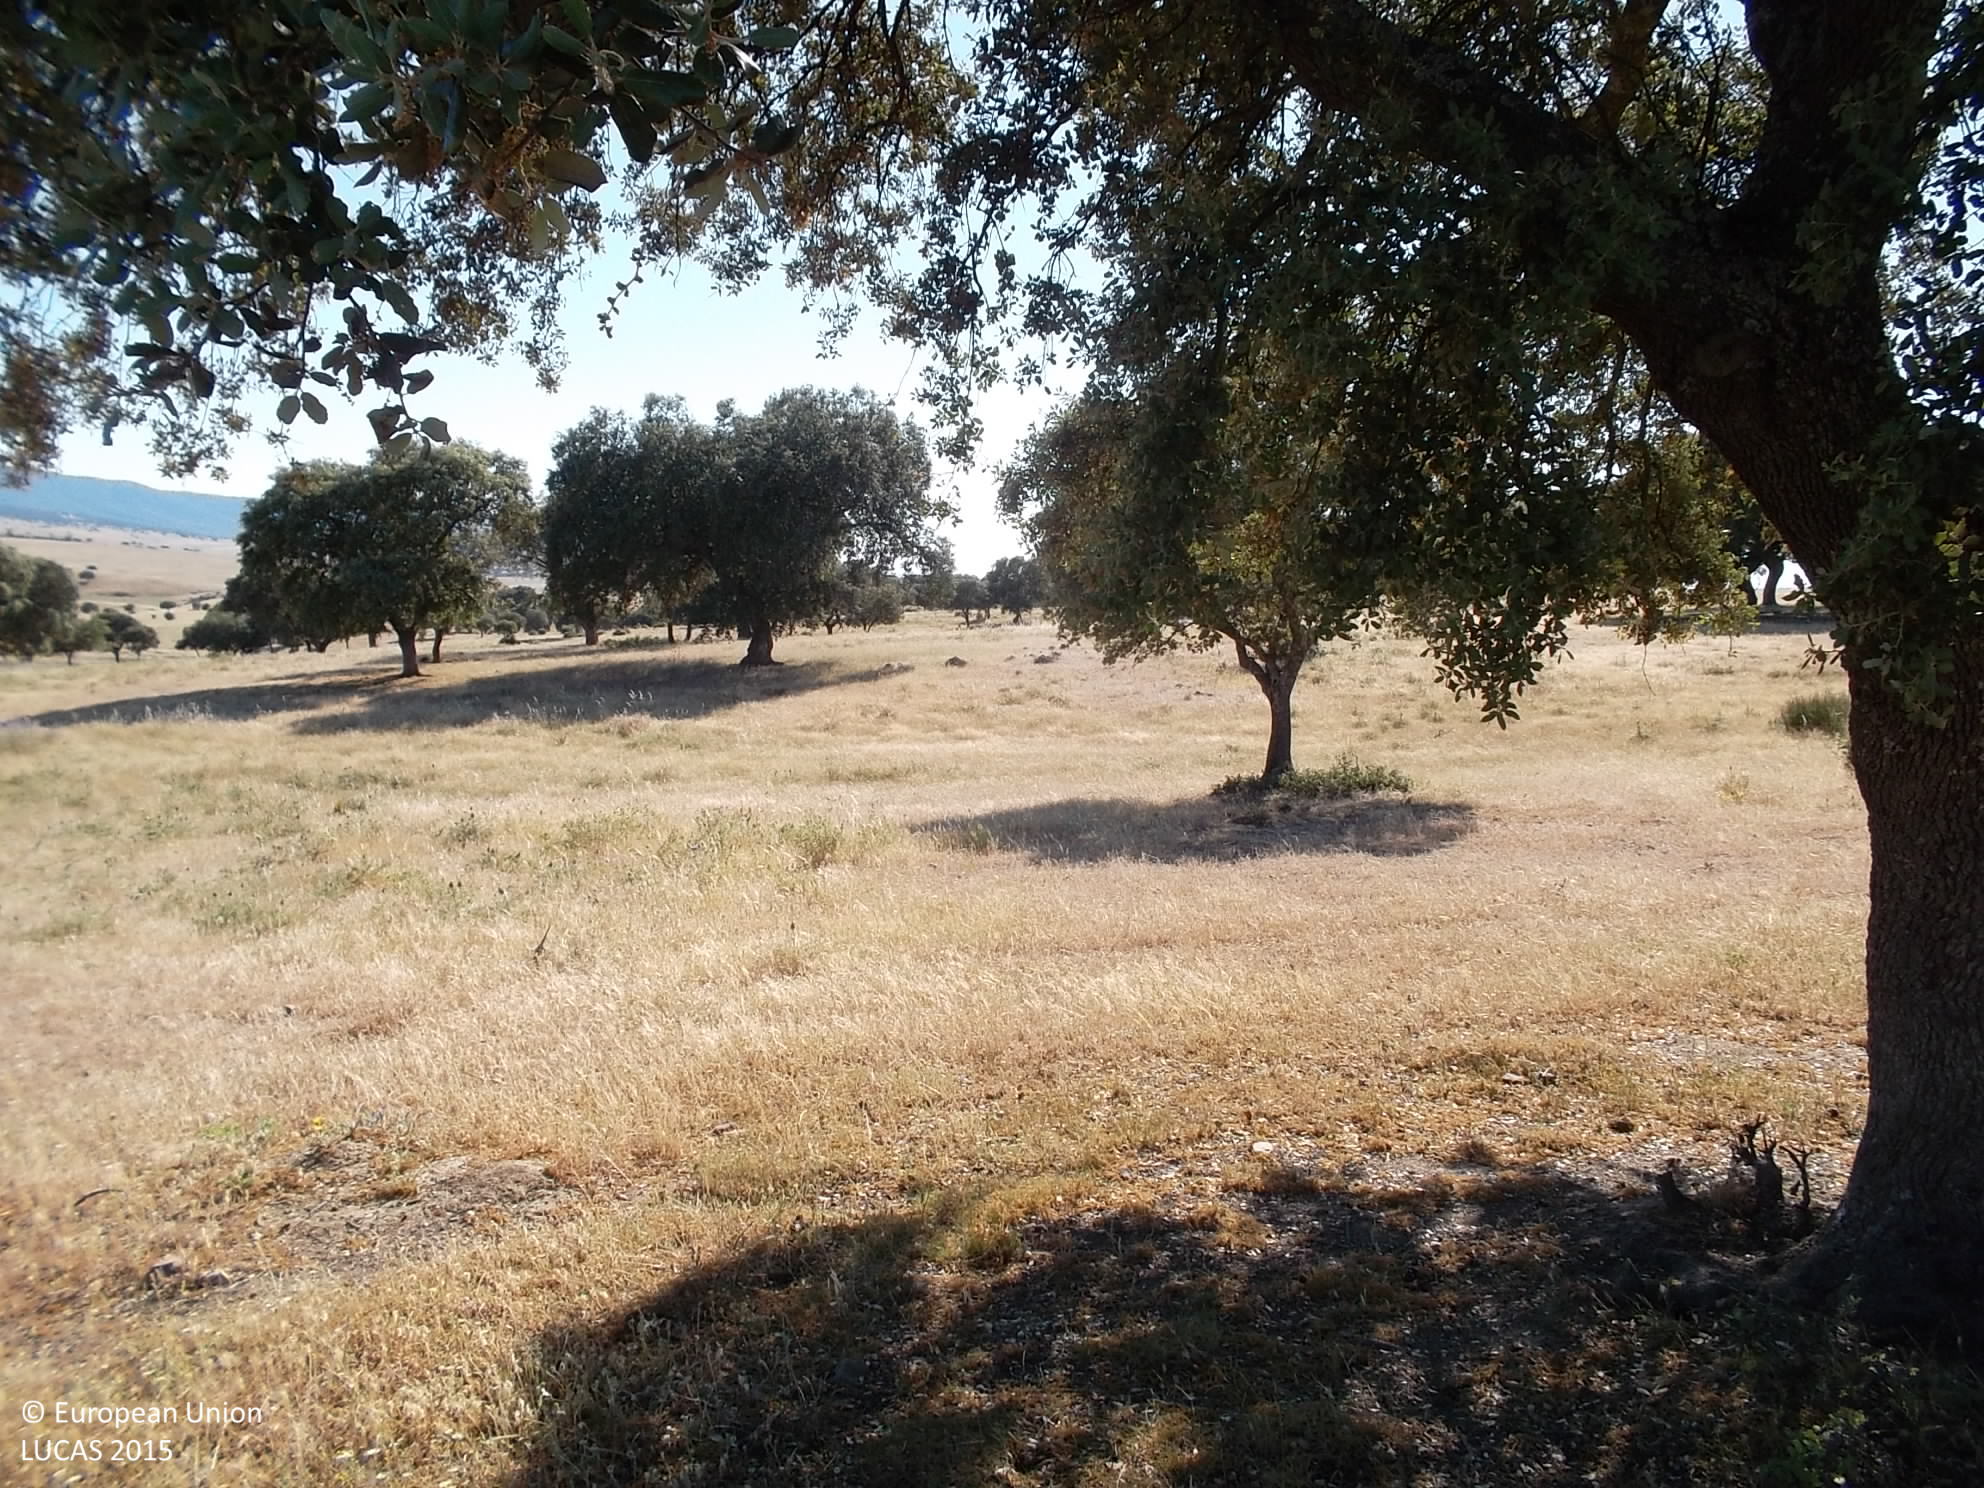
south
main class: Grassland
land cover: Grassland with sparse tree/shrub cover
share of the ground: 50 - 75 %
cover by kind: herbaceous plants 85 %, shrubs 10 %, broadleaved forest trees 5 %
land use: Agriculture (excluding fallow land and kitchen gardens)
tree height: > 5 m
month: May
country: ES
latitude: 38.6455
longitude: -4.4181
